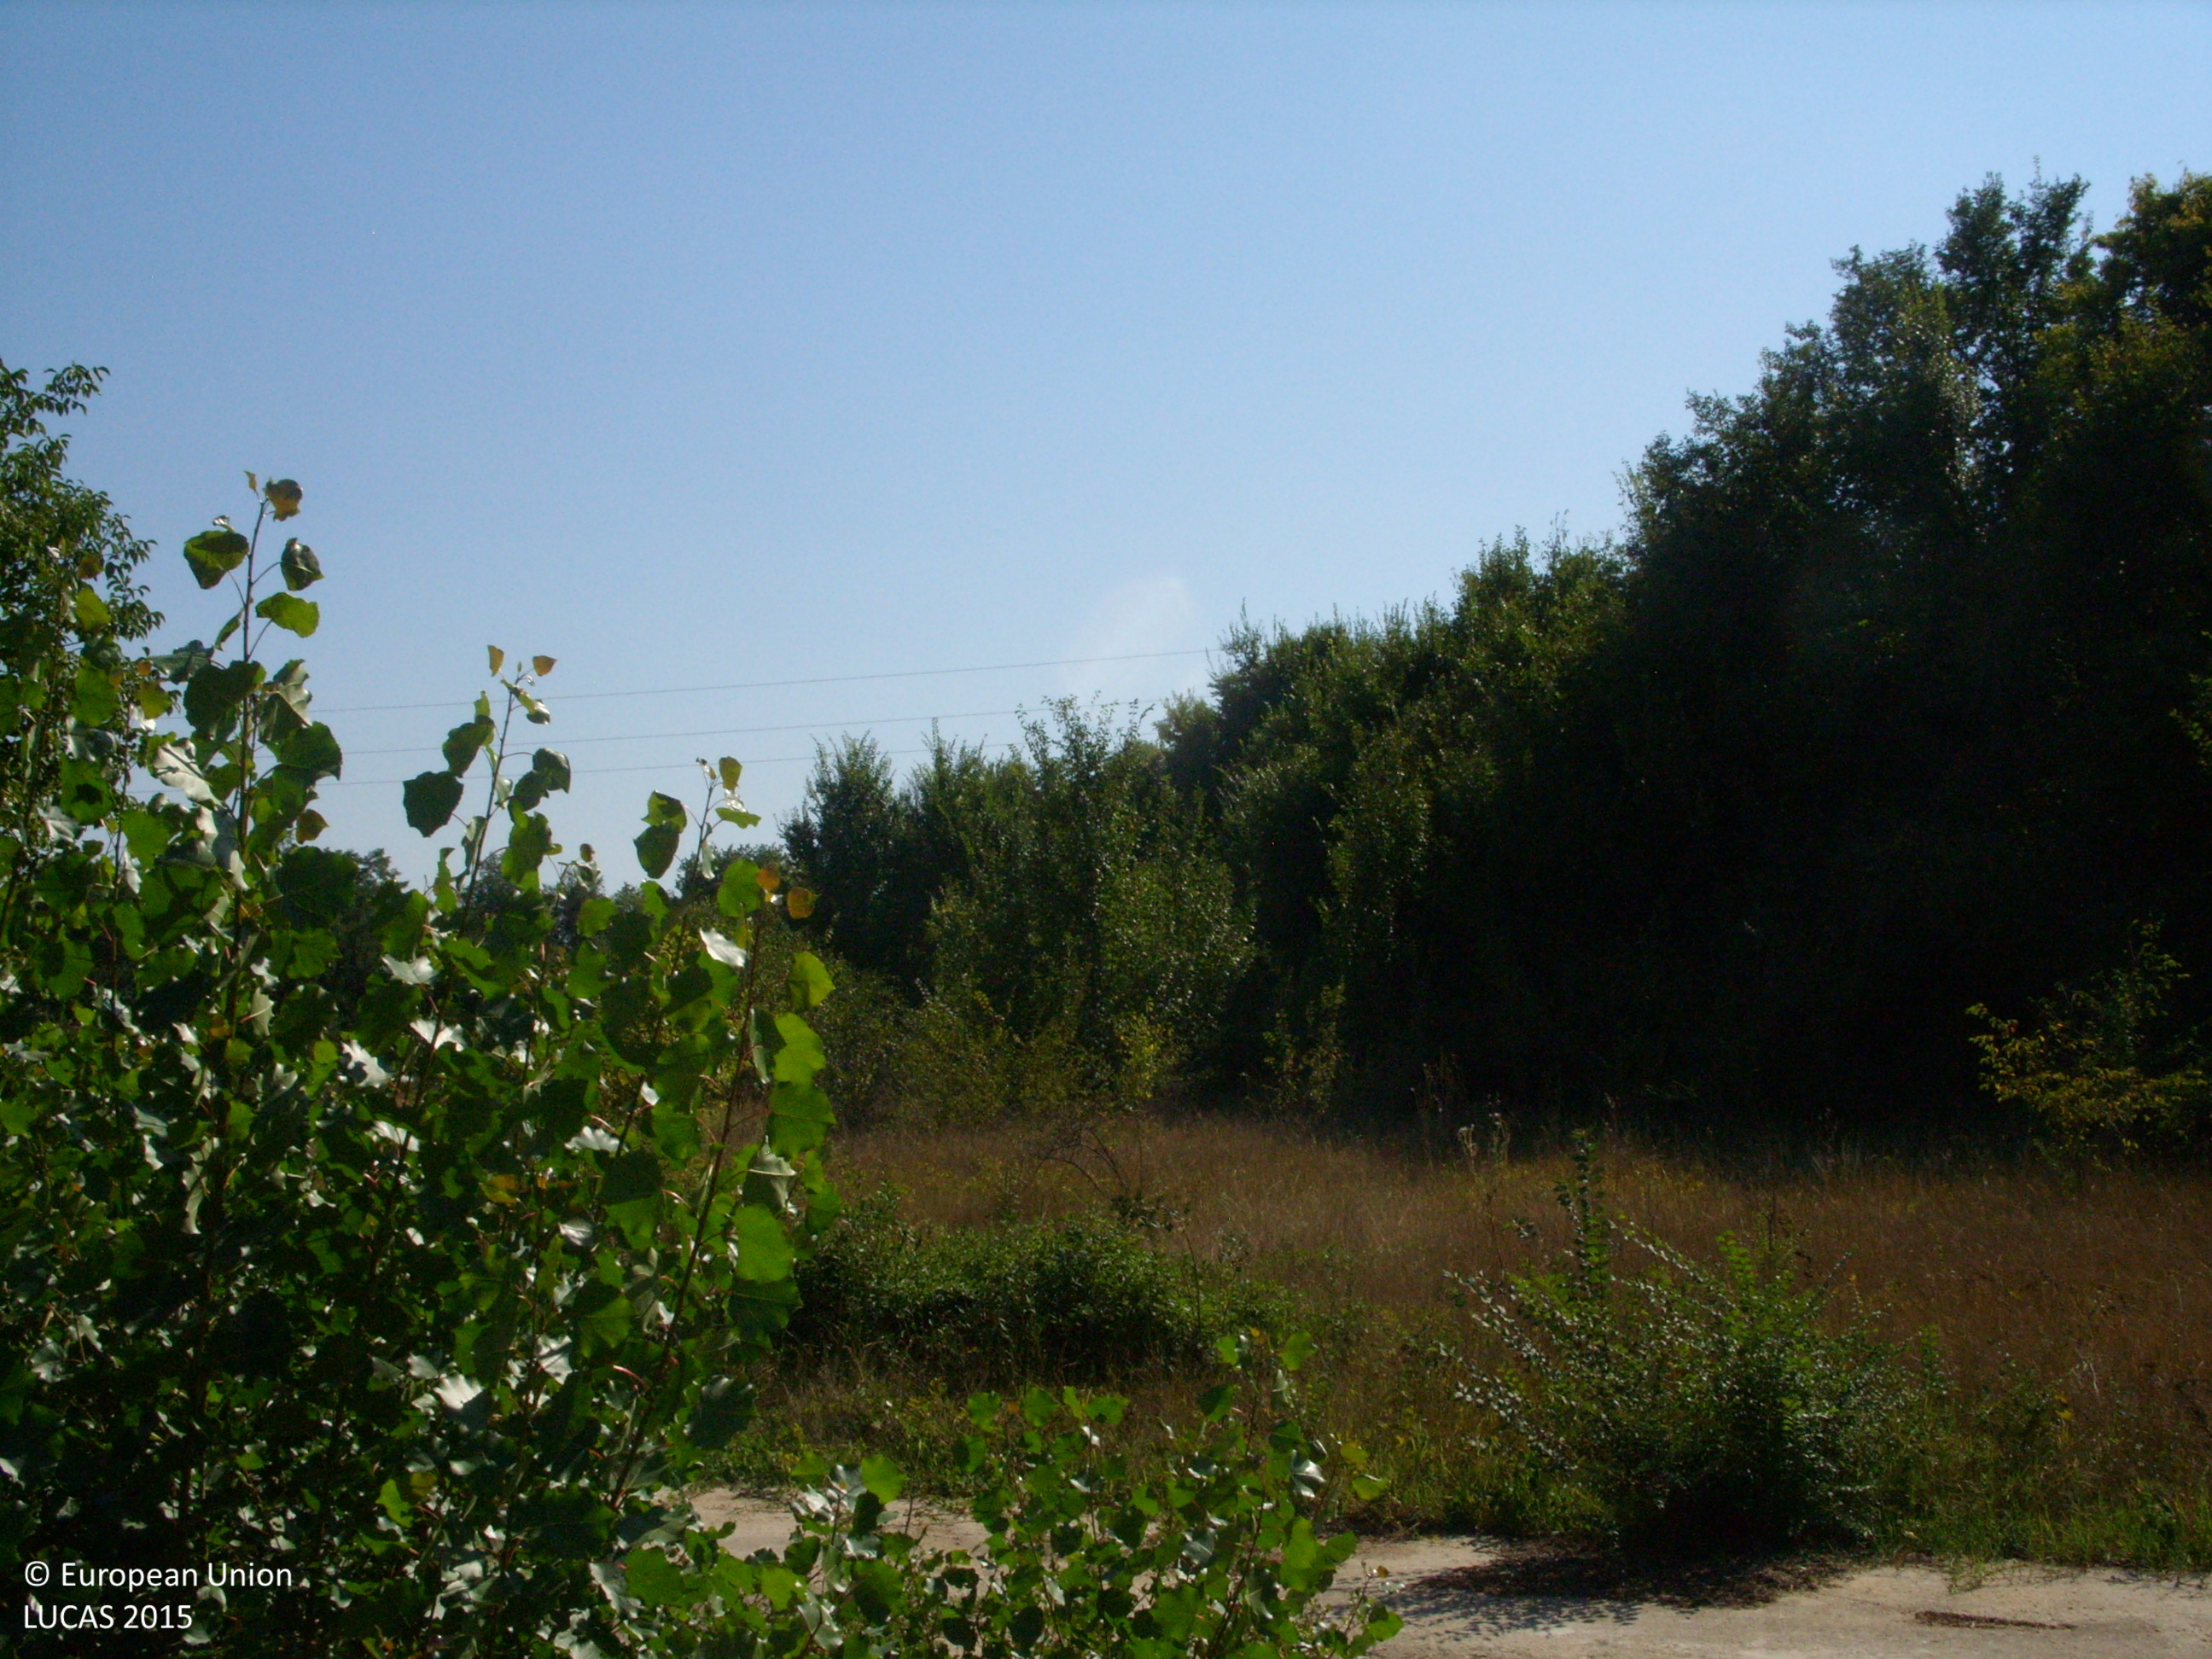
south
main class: Grassland
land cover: Grassland with sparse tree/shrub cover
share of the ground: > 75 %
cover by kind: herbaceous plants 90 %, broadleaved forest trees 5 %, shrubs 5 %
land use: Water supply and treatment
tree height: < 5 m
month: August
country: BG
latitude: 42.3788
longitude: 25.0839
